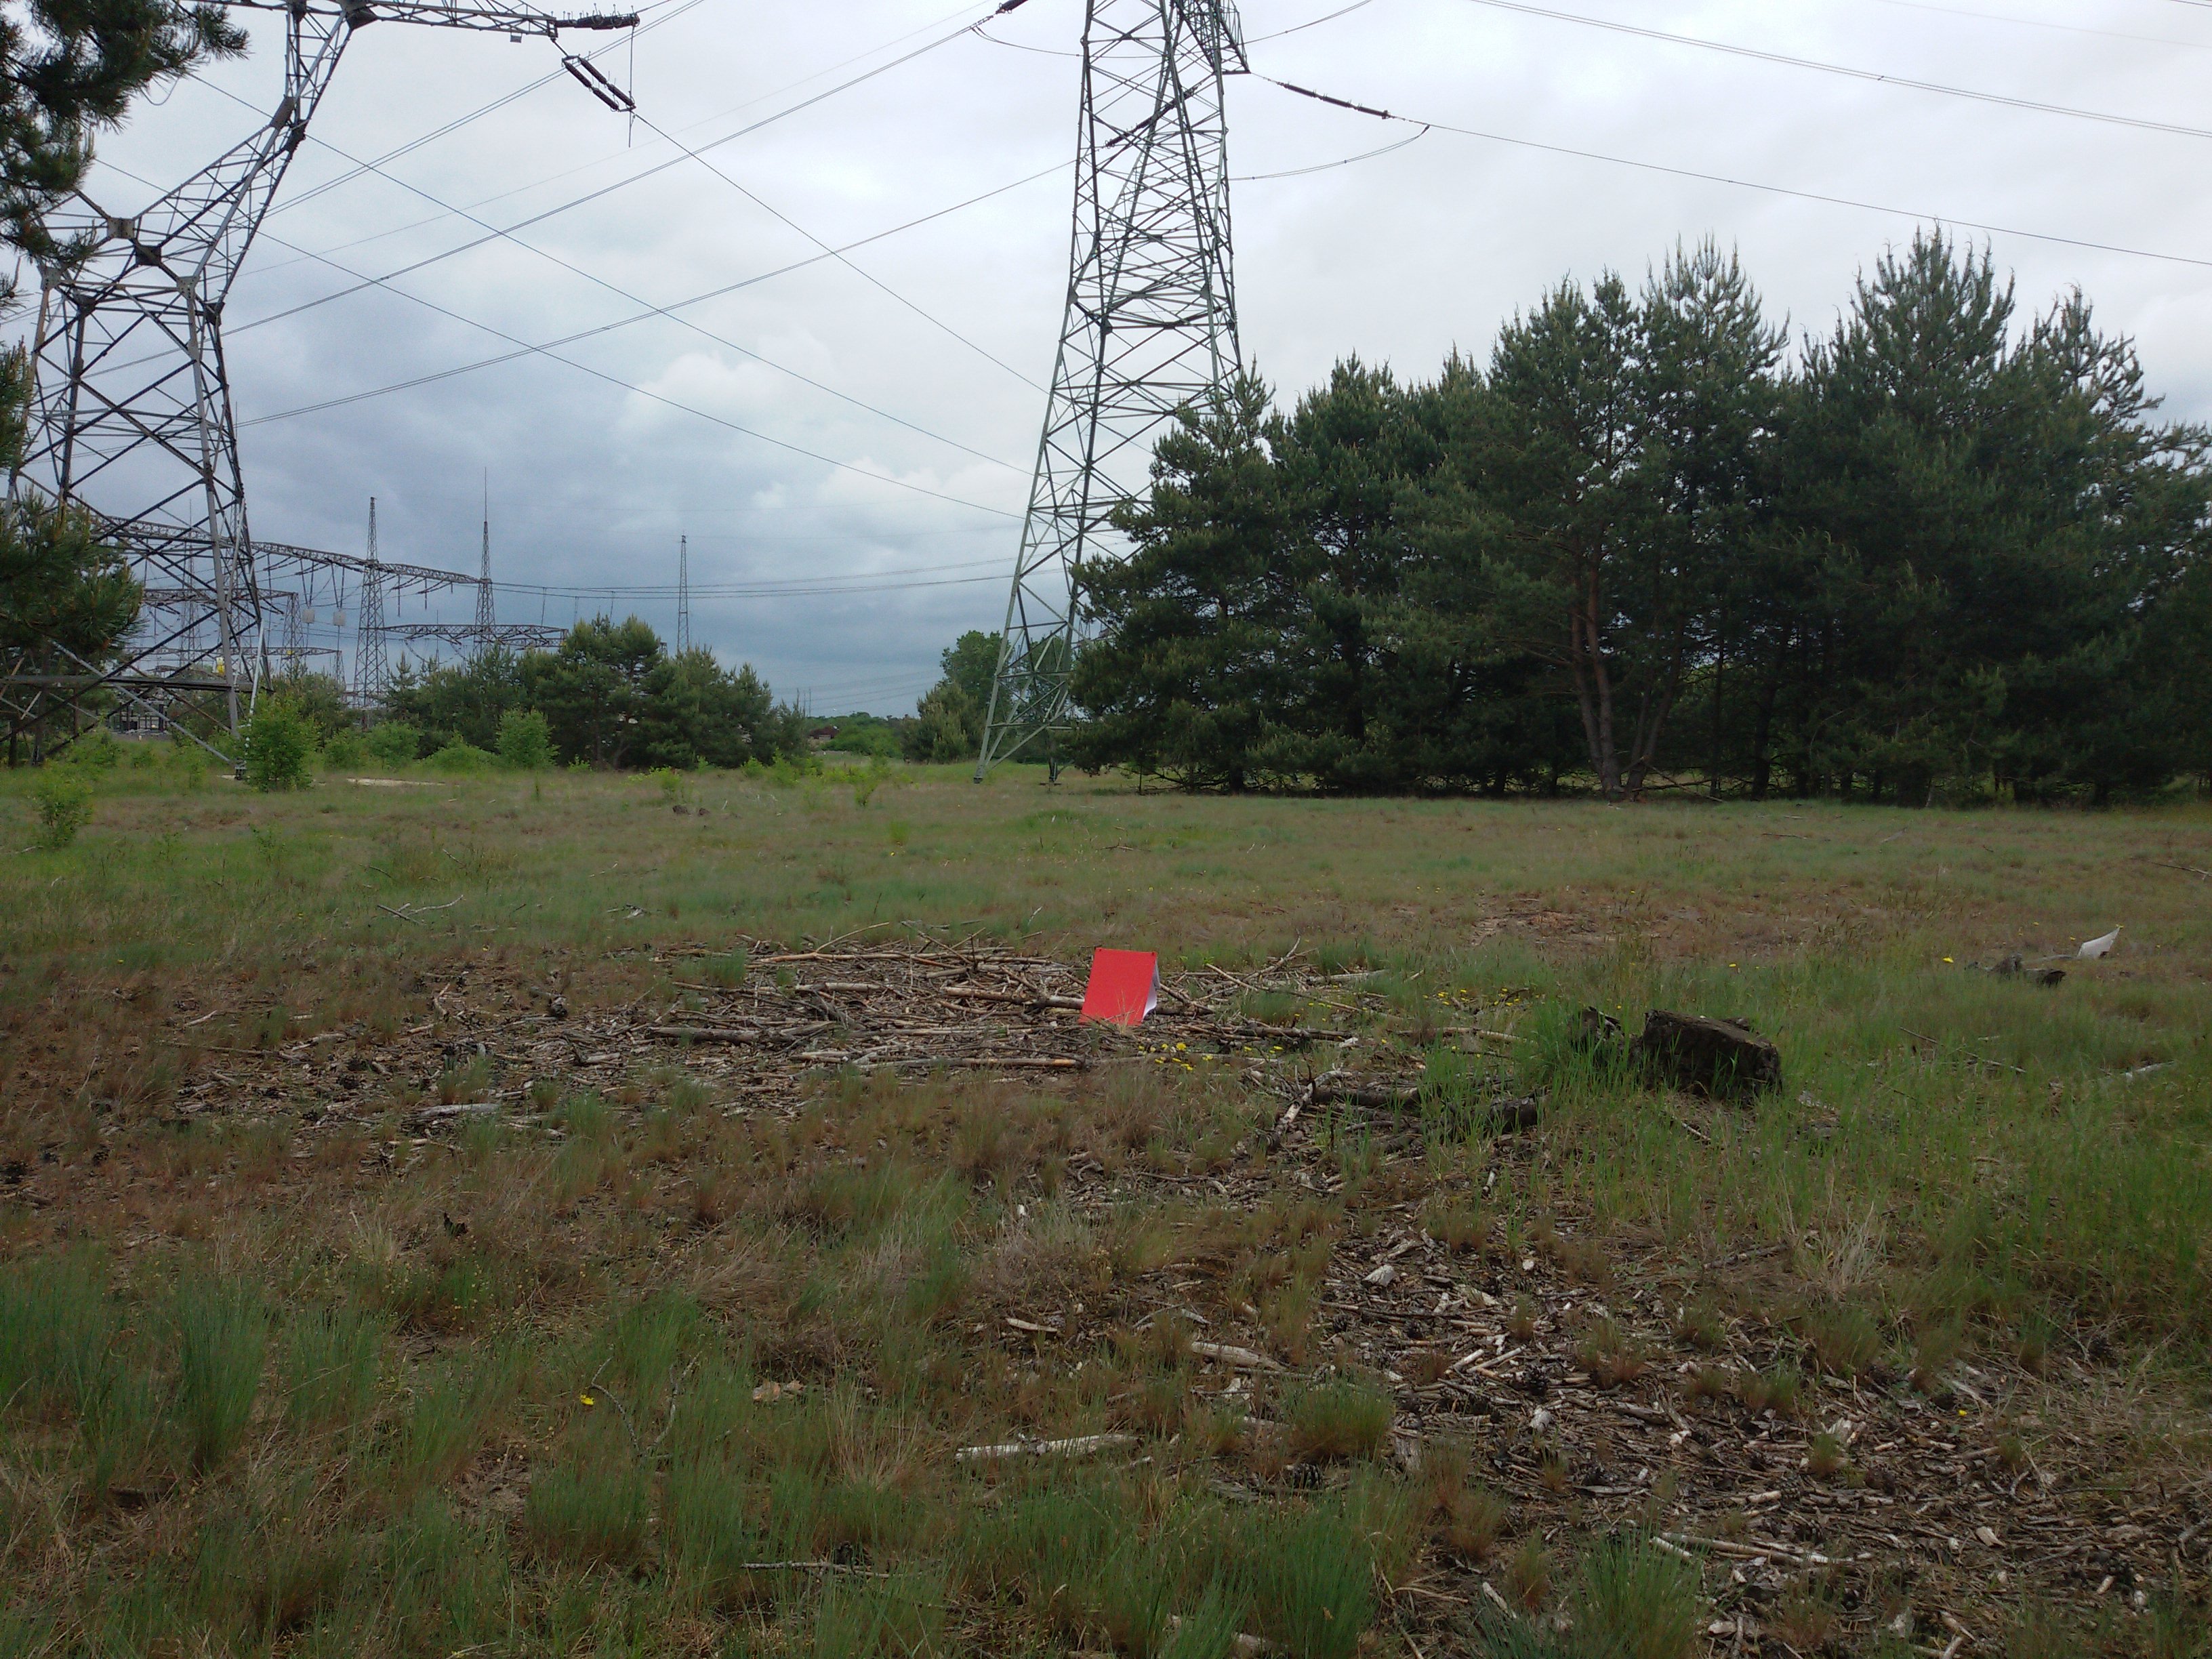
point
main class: Grassland
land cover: Grassland with sparse tree/shrub cover
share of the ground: > 75 %
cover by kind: herbaceous plants 95 %, coniferous forest trees 5 %
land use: Forestry
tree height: > 5 m
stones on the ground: < 10 %
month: May
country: PL
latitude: 53.1932
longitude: 14.4765
